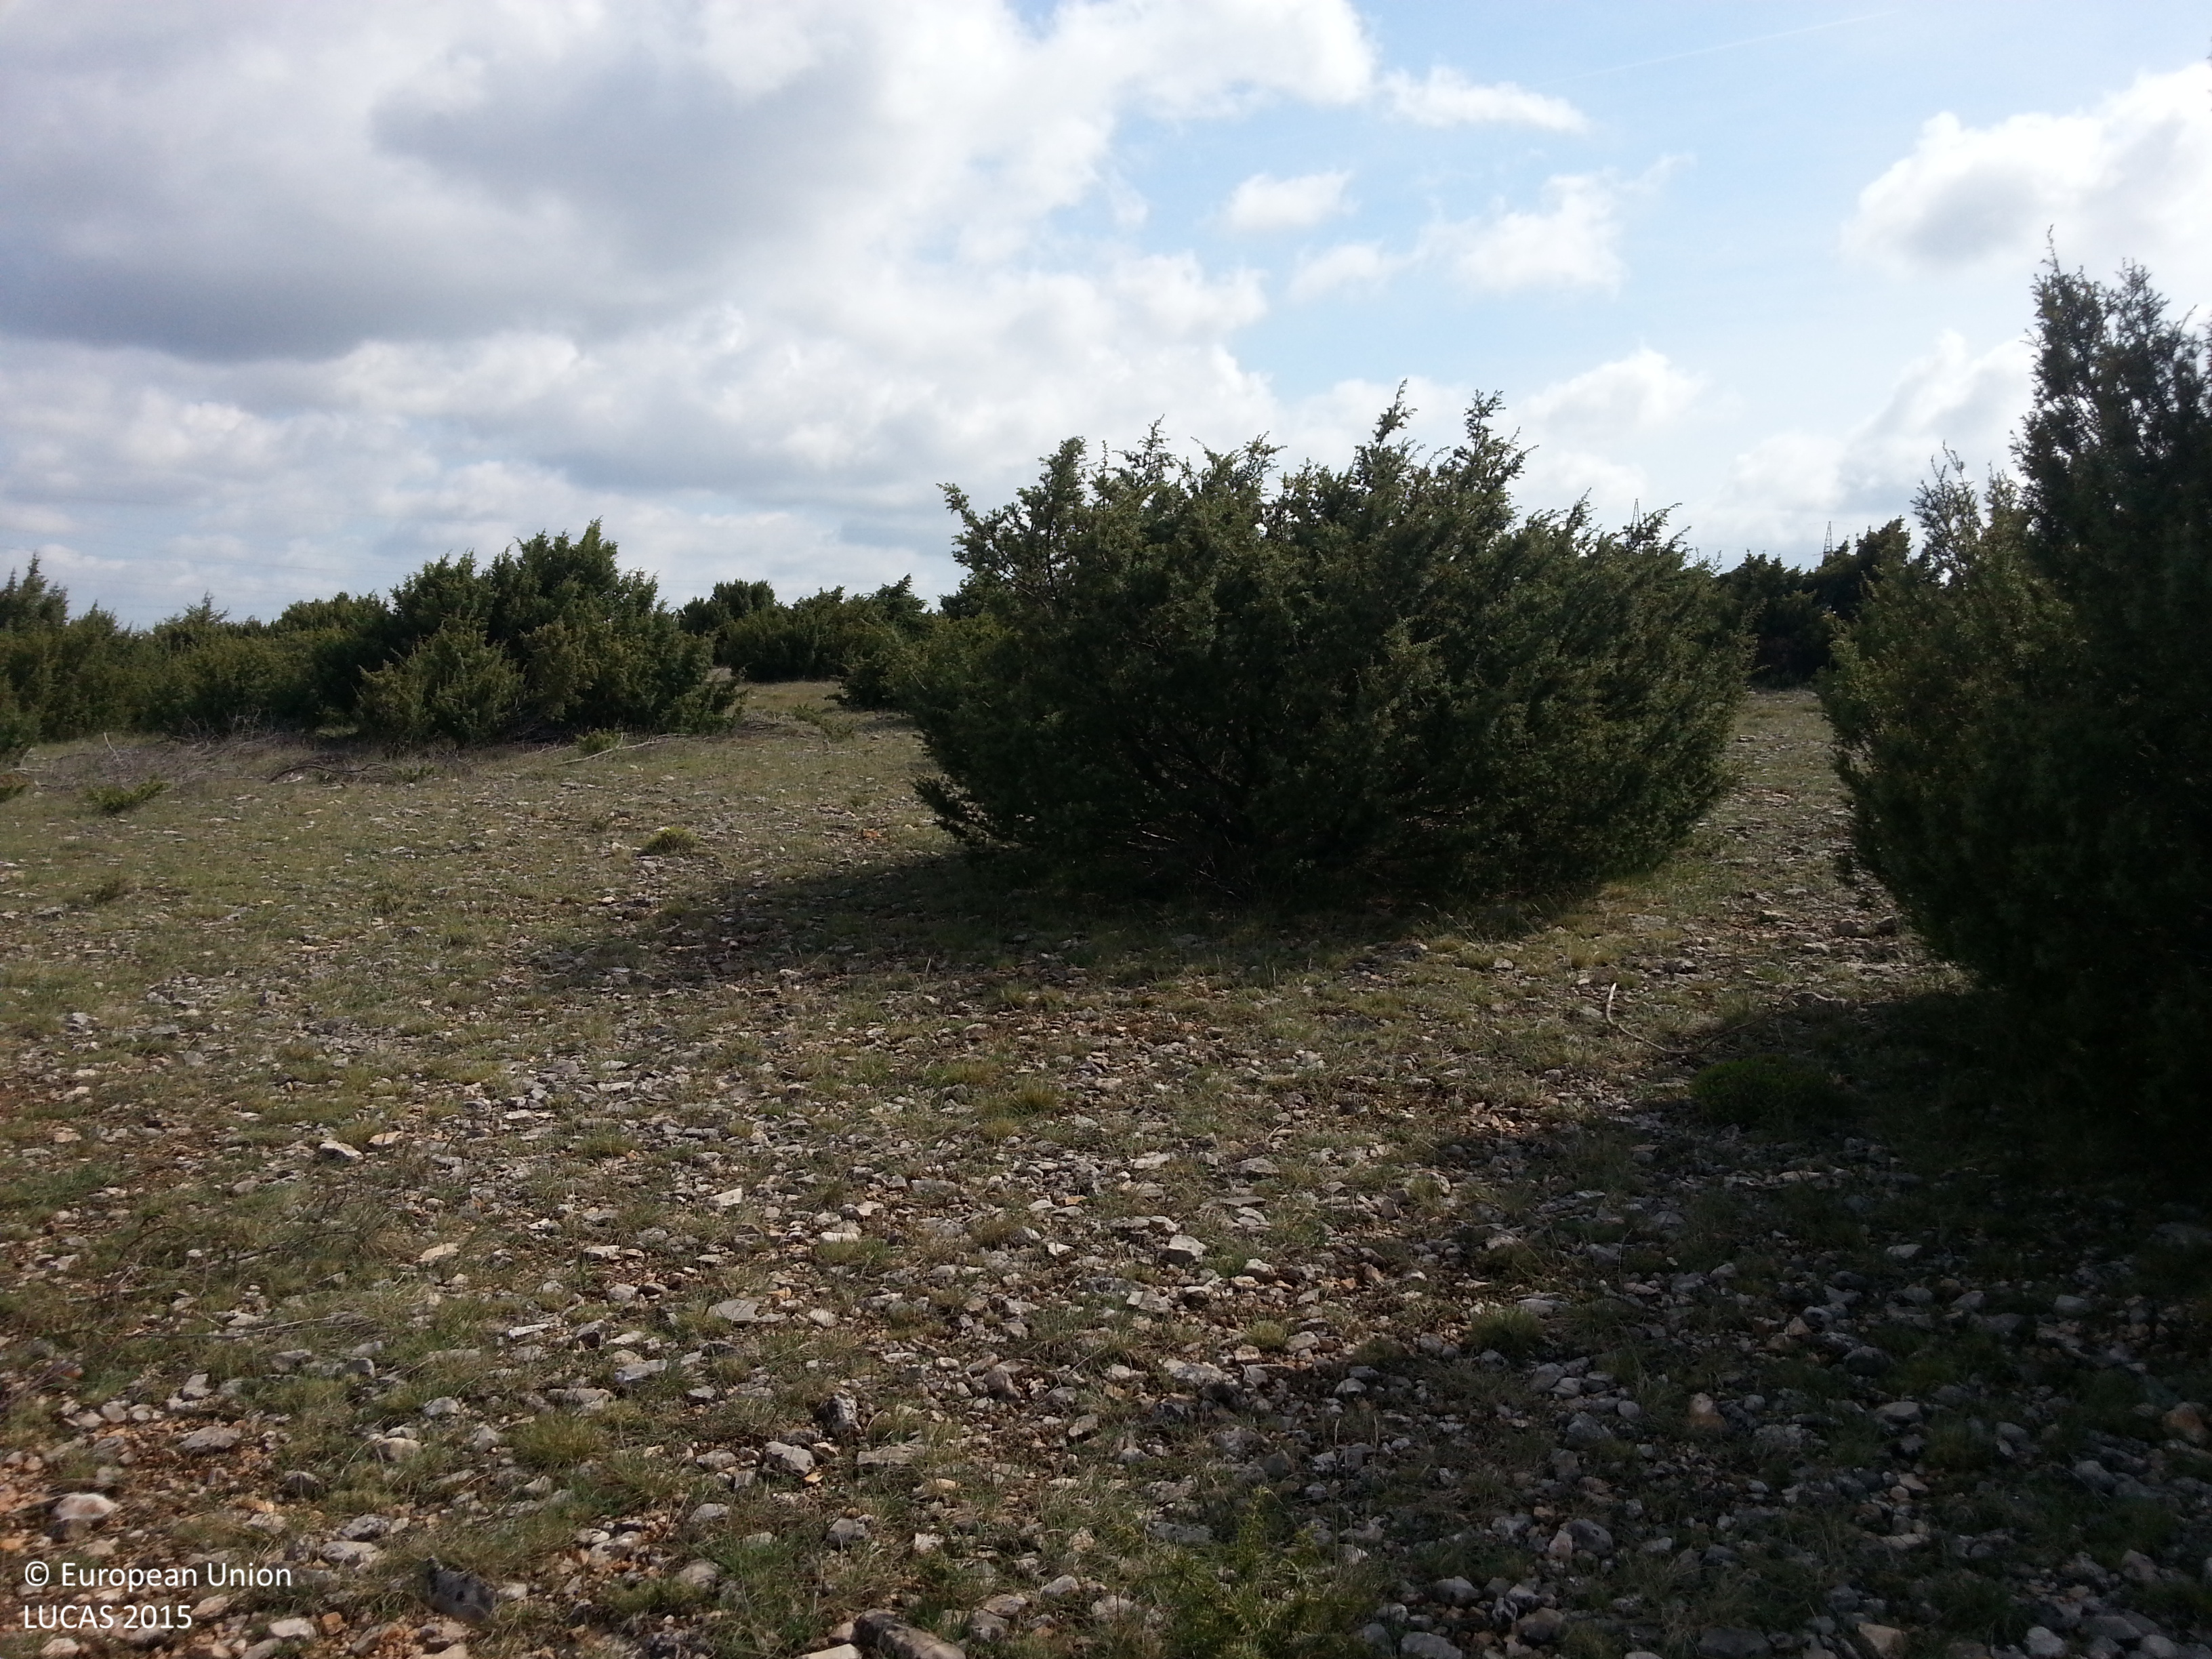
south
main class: Shrubland
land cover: Shrubland without tree cover
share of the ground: 50 - 75 %
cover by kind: shrubs 55 %, herbaceous plants 25 %, unconsolidated bare surface 20 %
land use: Abandoned areas
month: April
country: HR
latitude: 44.0342
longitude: 15.6445
